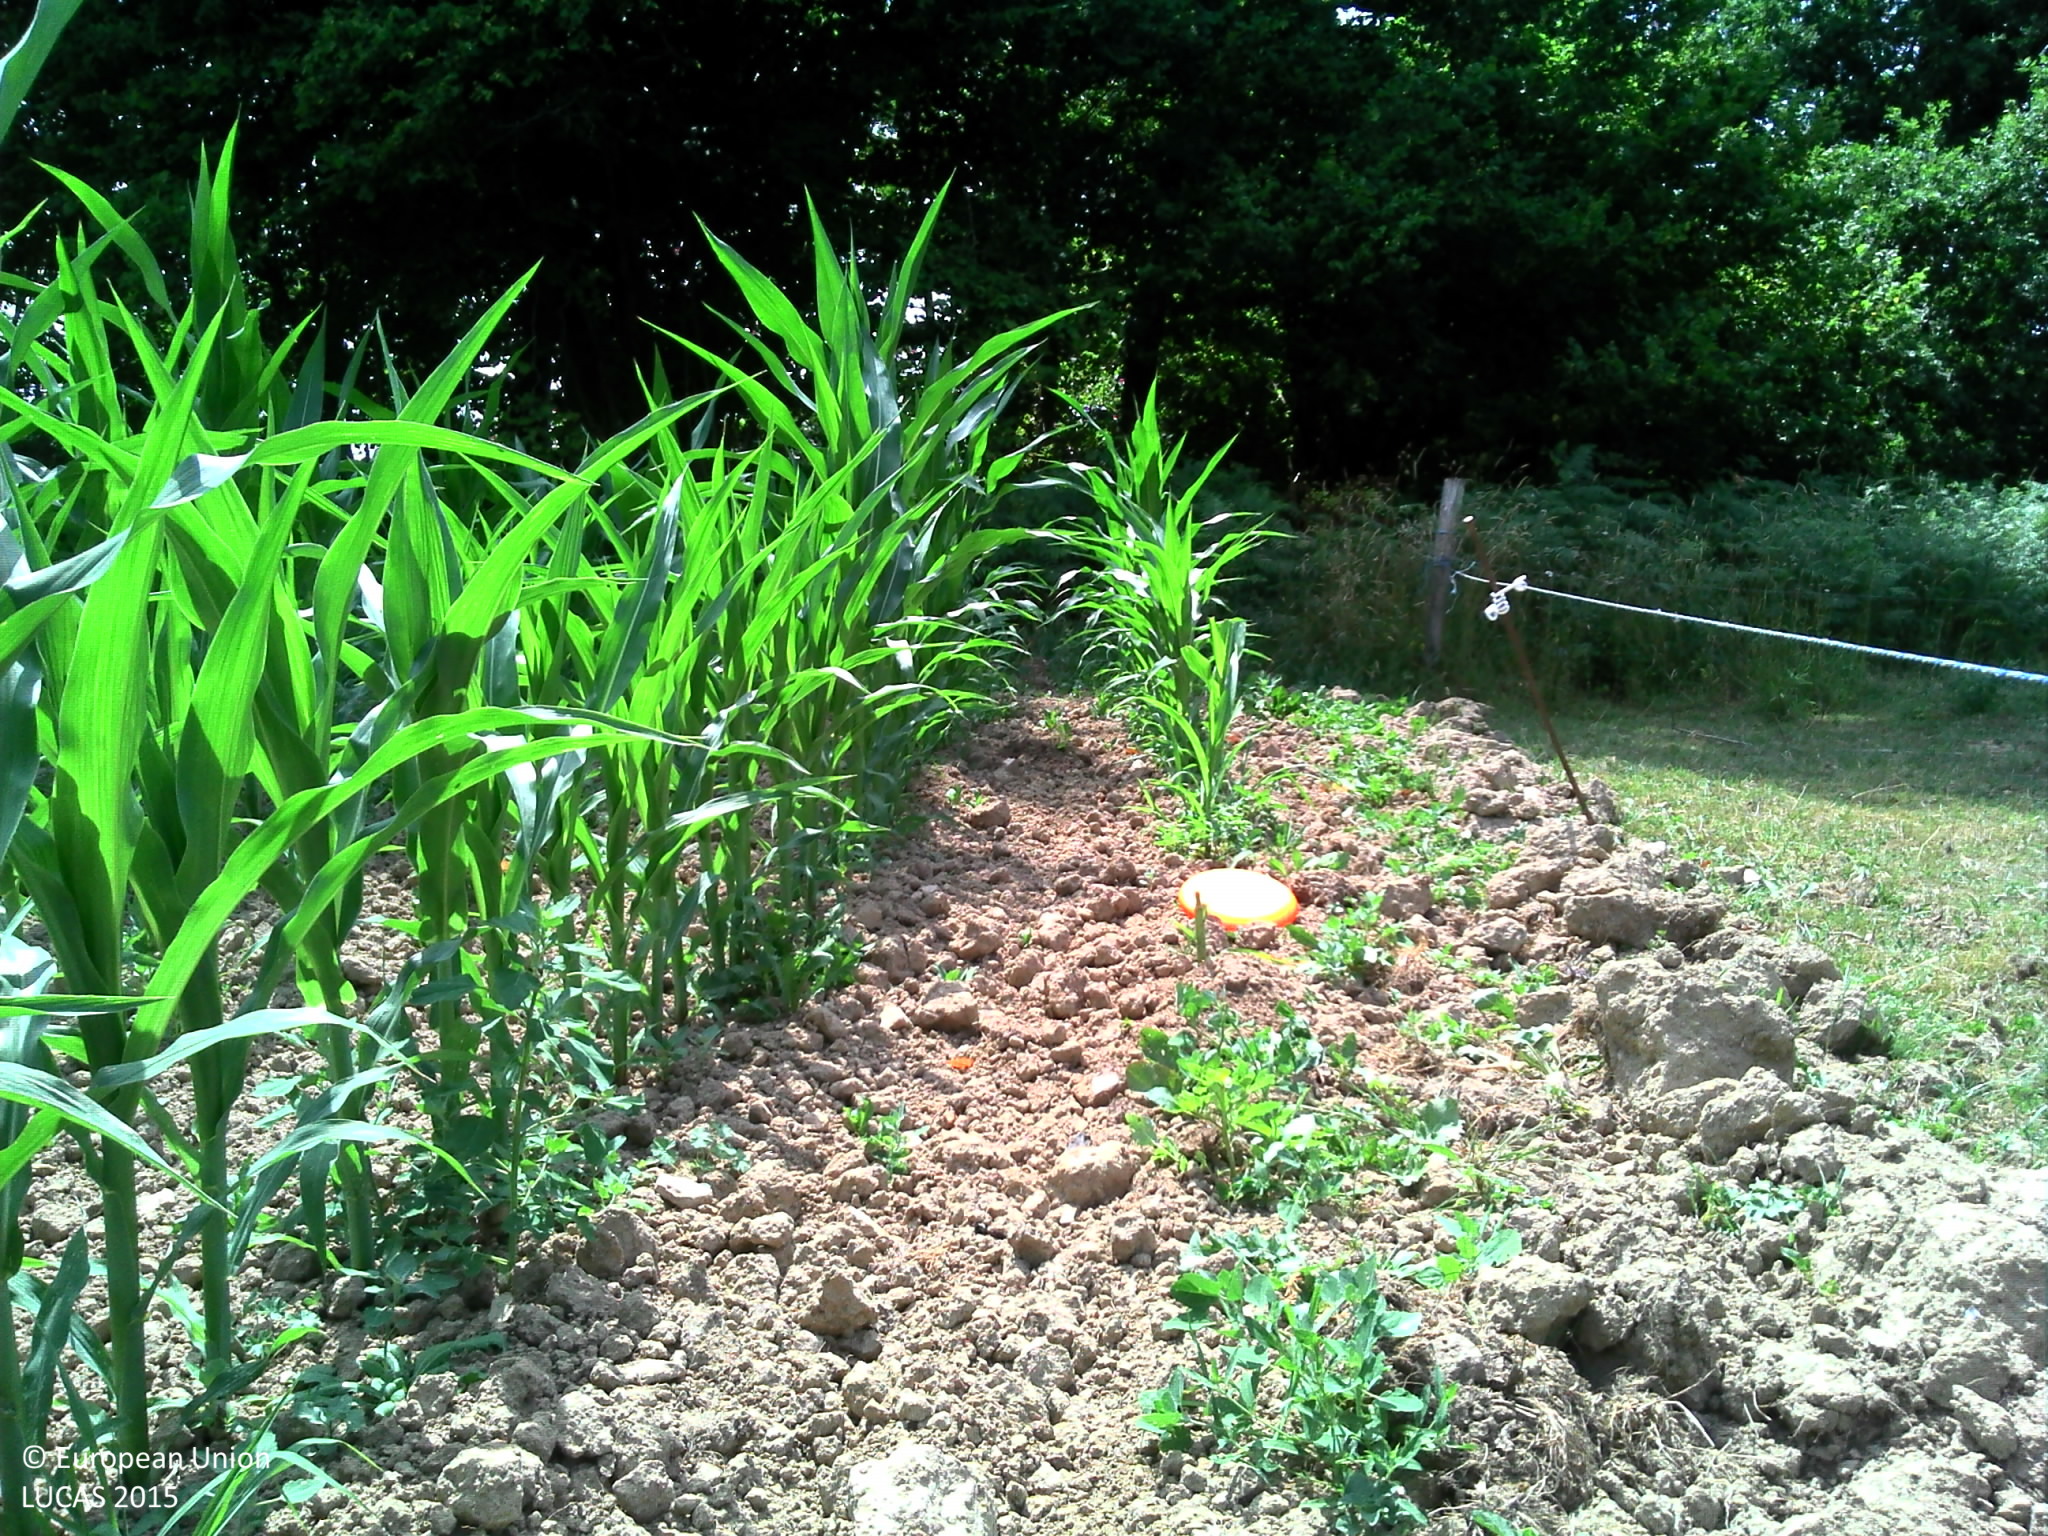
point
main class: Cropland
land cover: Maize
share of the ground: > 75 %
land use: Agriculture (excluding fallow land and kitchen gardens)
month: July
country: FR
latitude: 45.7204
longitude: 1.0348
